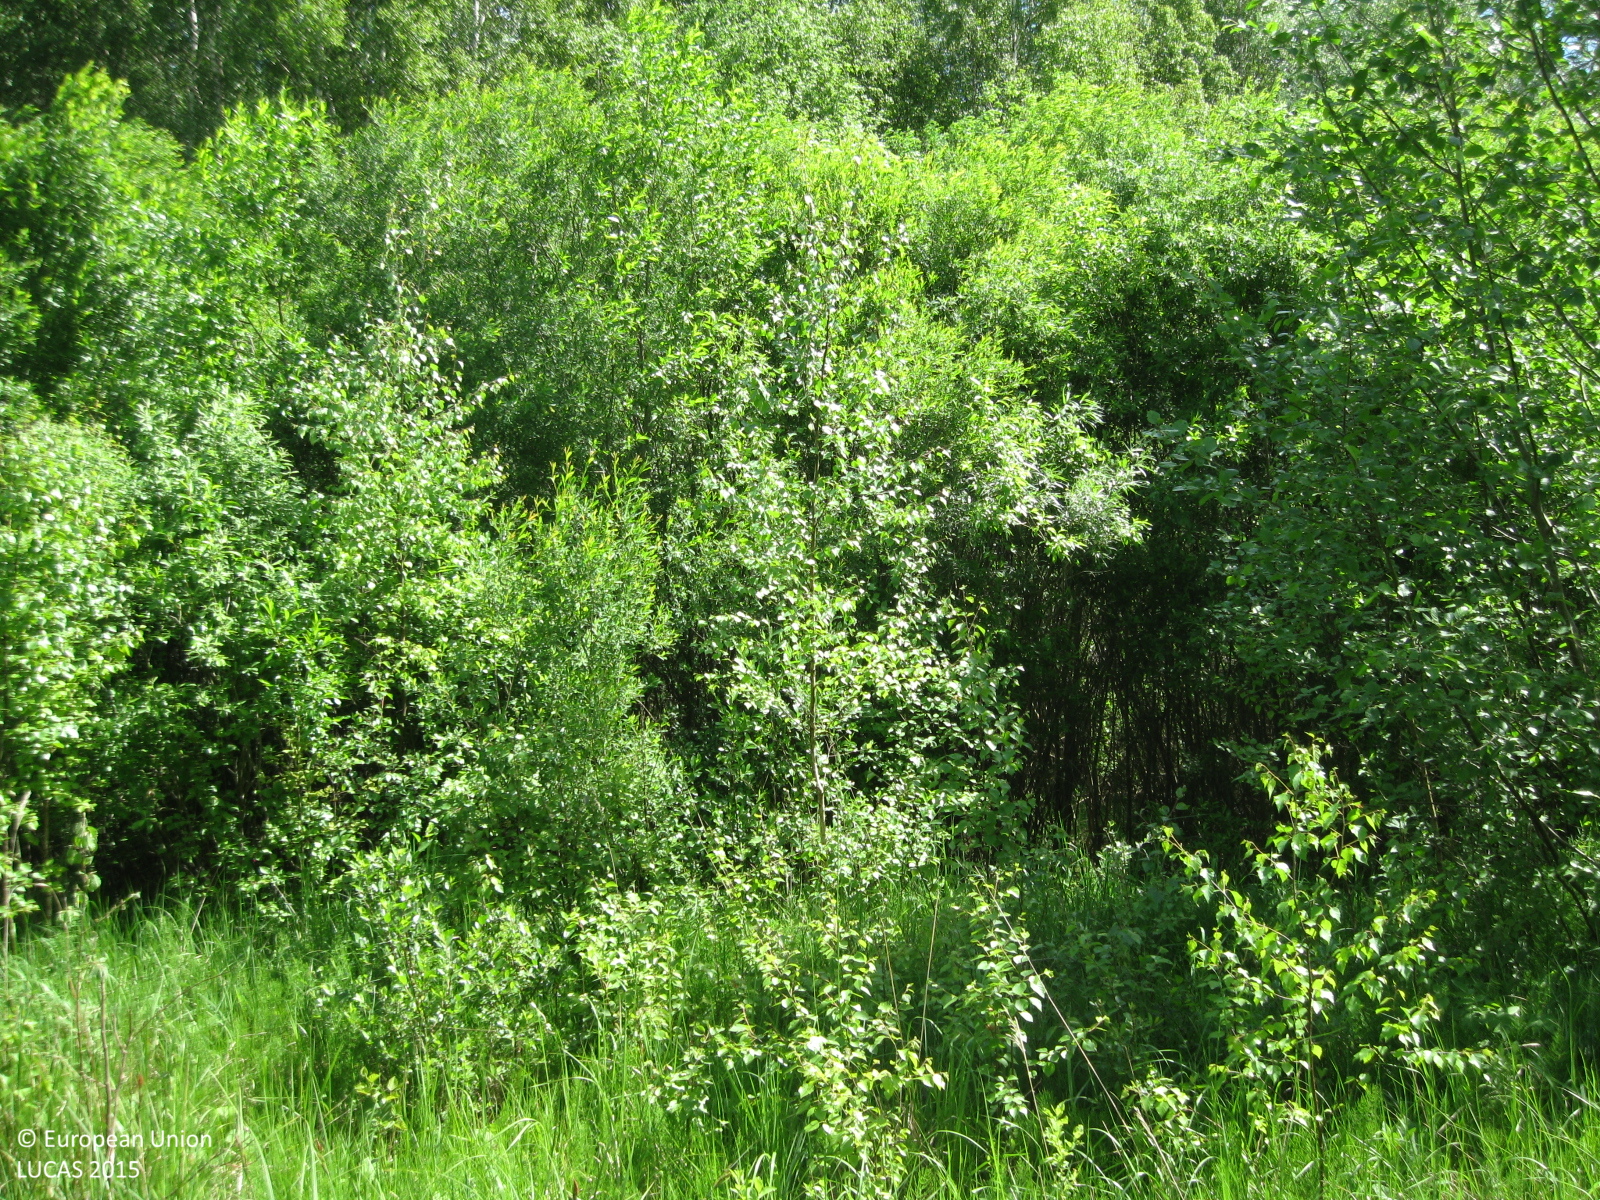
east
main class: Woodland
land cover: Broadleaved woodland
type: floodplain forest
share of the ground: > 75 %
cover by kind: broadleaved forest trees 70 %, coniferous forest trees 15 %, herbaceous plants 10 %, shrubs 5 %
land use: Forestry
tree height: > 5 m
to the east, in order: Broadleaved woodland; Inland fresh running water; Broadleaved woodland; Spruce dominated coniferous woodland; Spruce dominated mixed woodland; Grass margins; Tracks; Maize
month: June
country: LT
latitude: 55.6382
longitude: 23.6323
